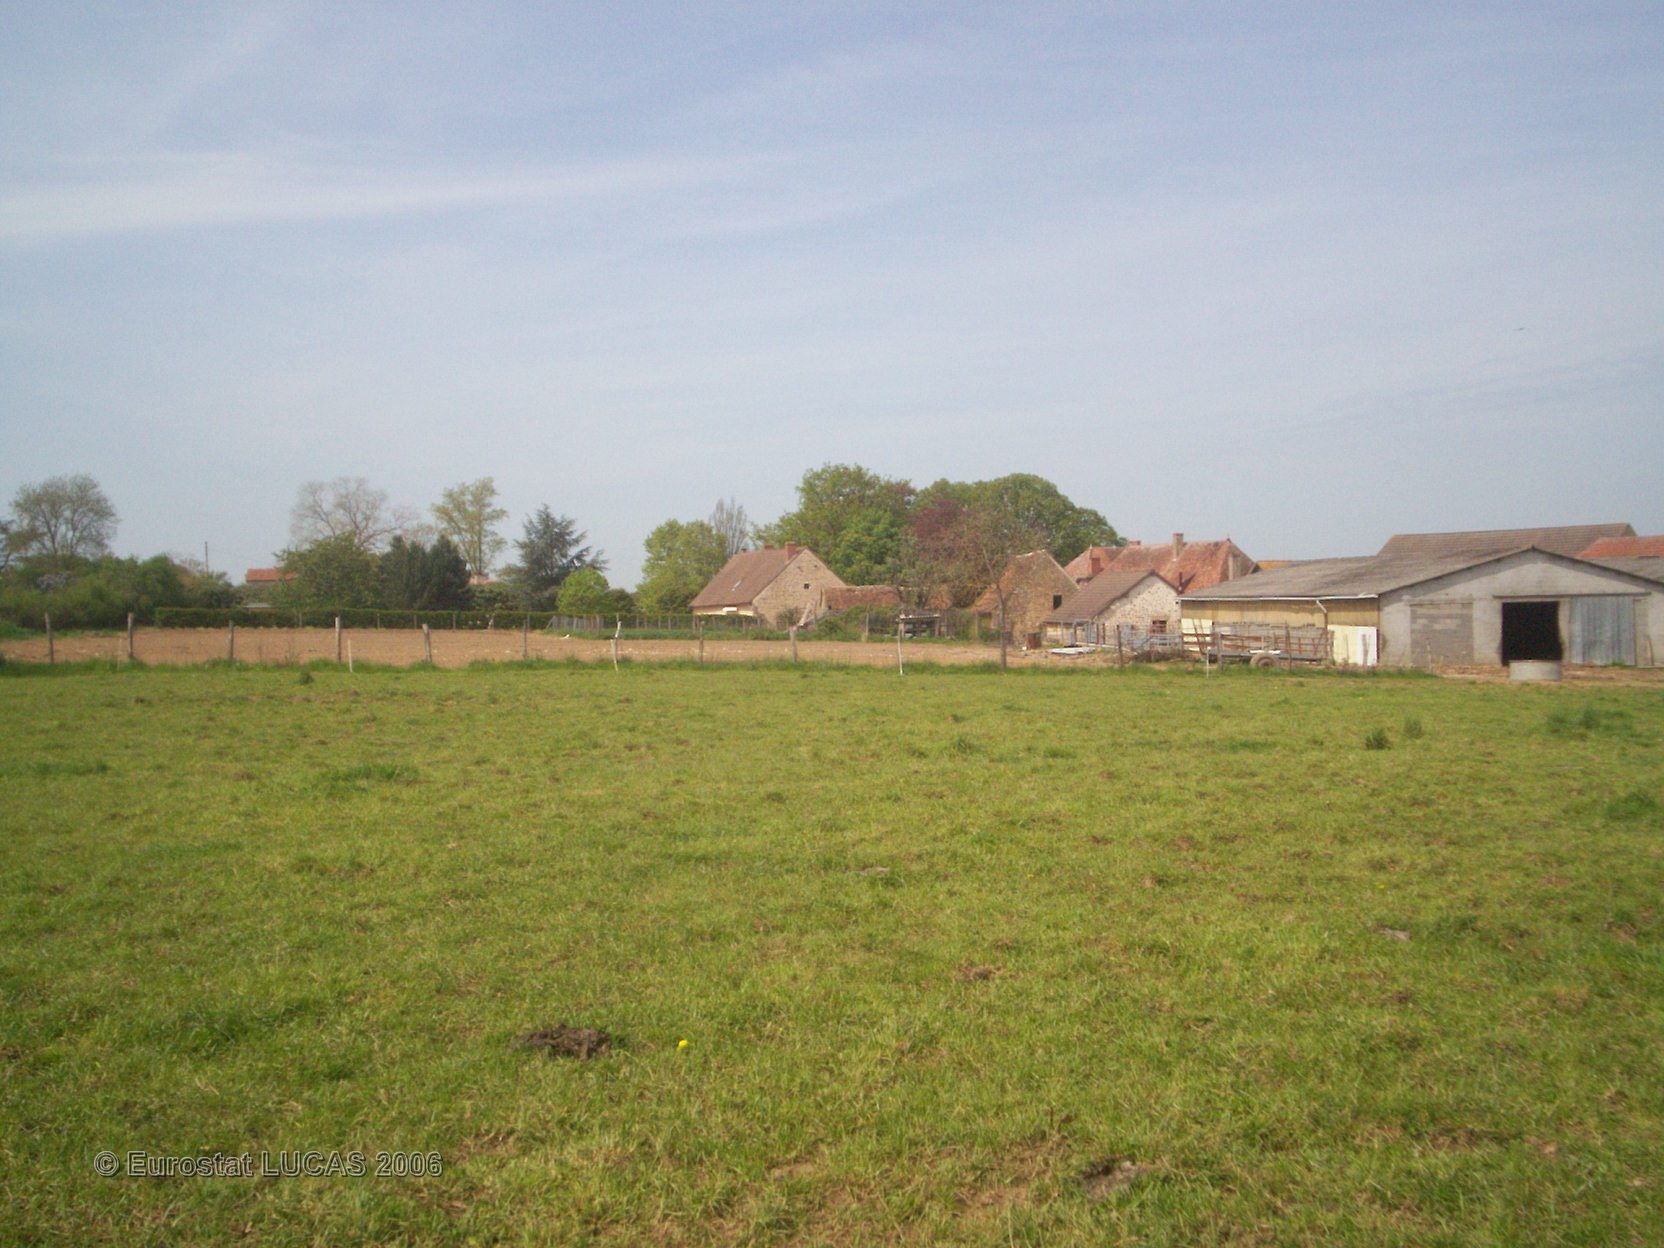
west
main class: Grassland
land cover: Grassland without tree/shrub cover
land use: Agriculture (excluding fallow land and kitchen gardens)
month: May
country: FR
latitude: 46.5601
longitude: 3.0705
